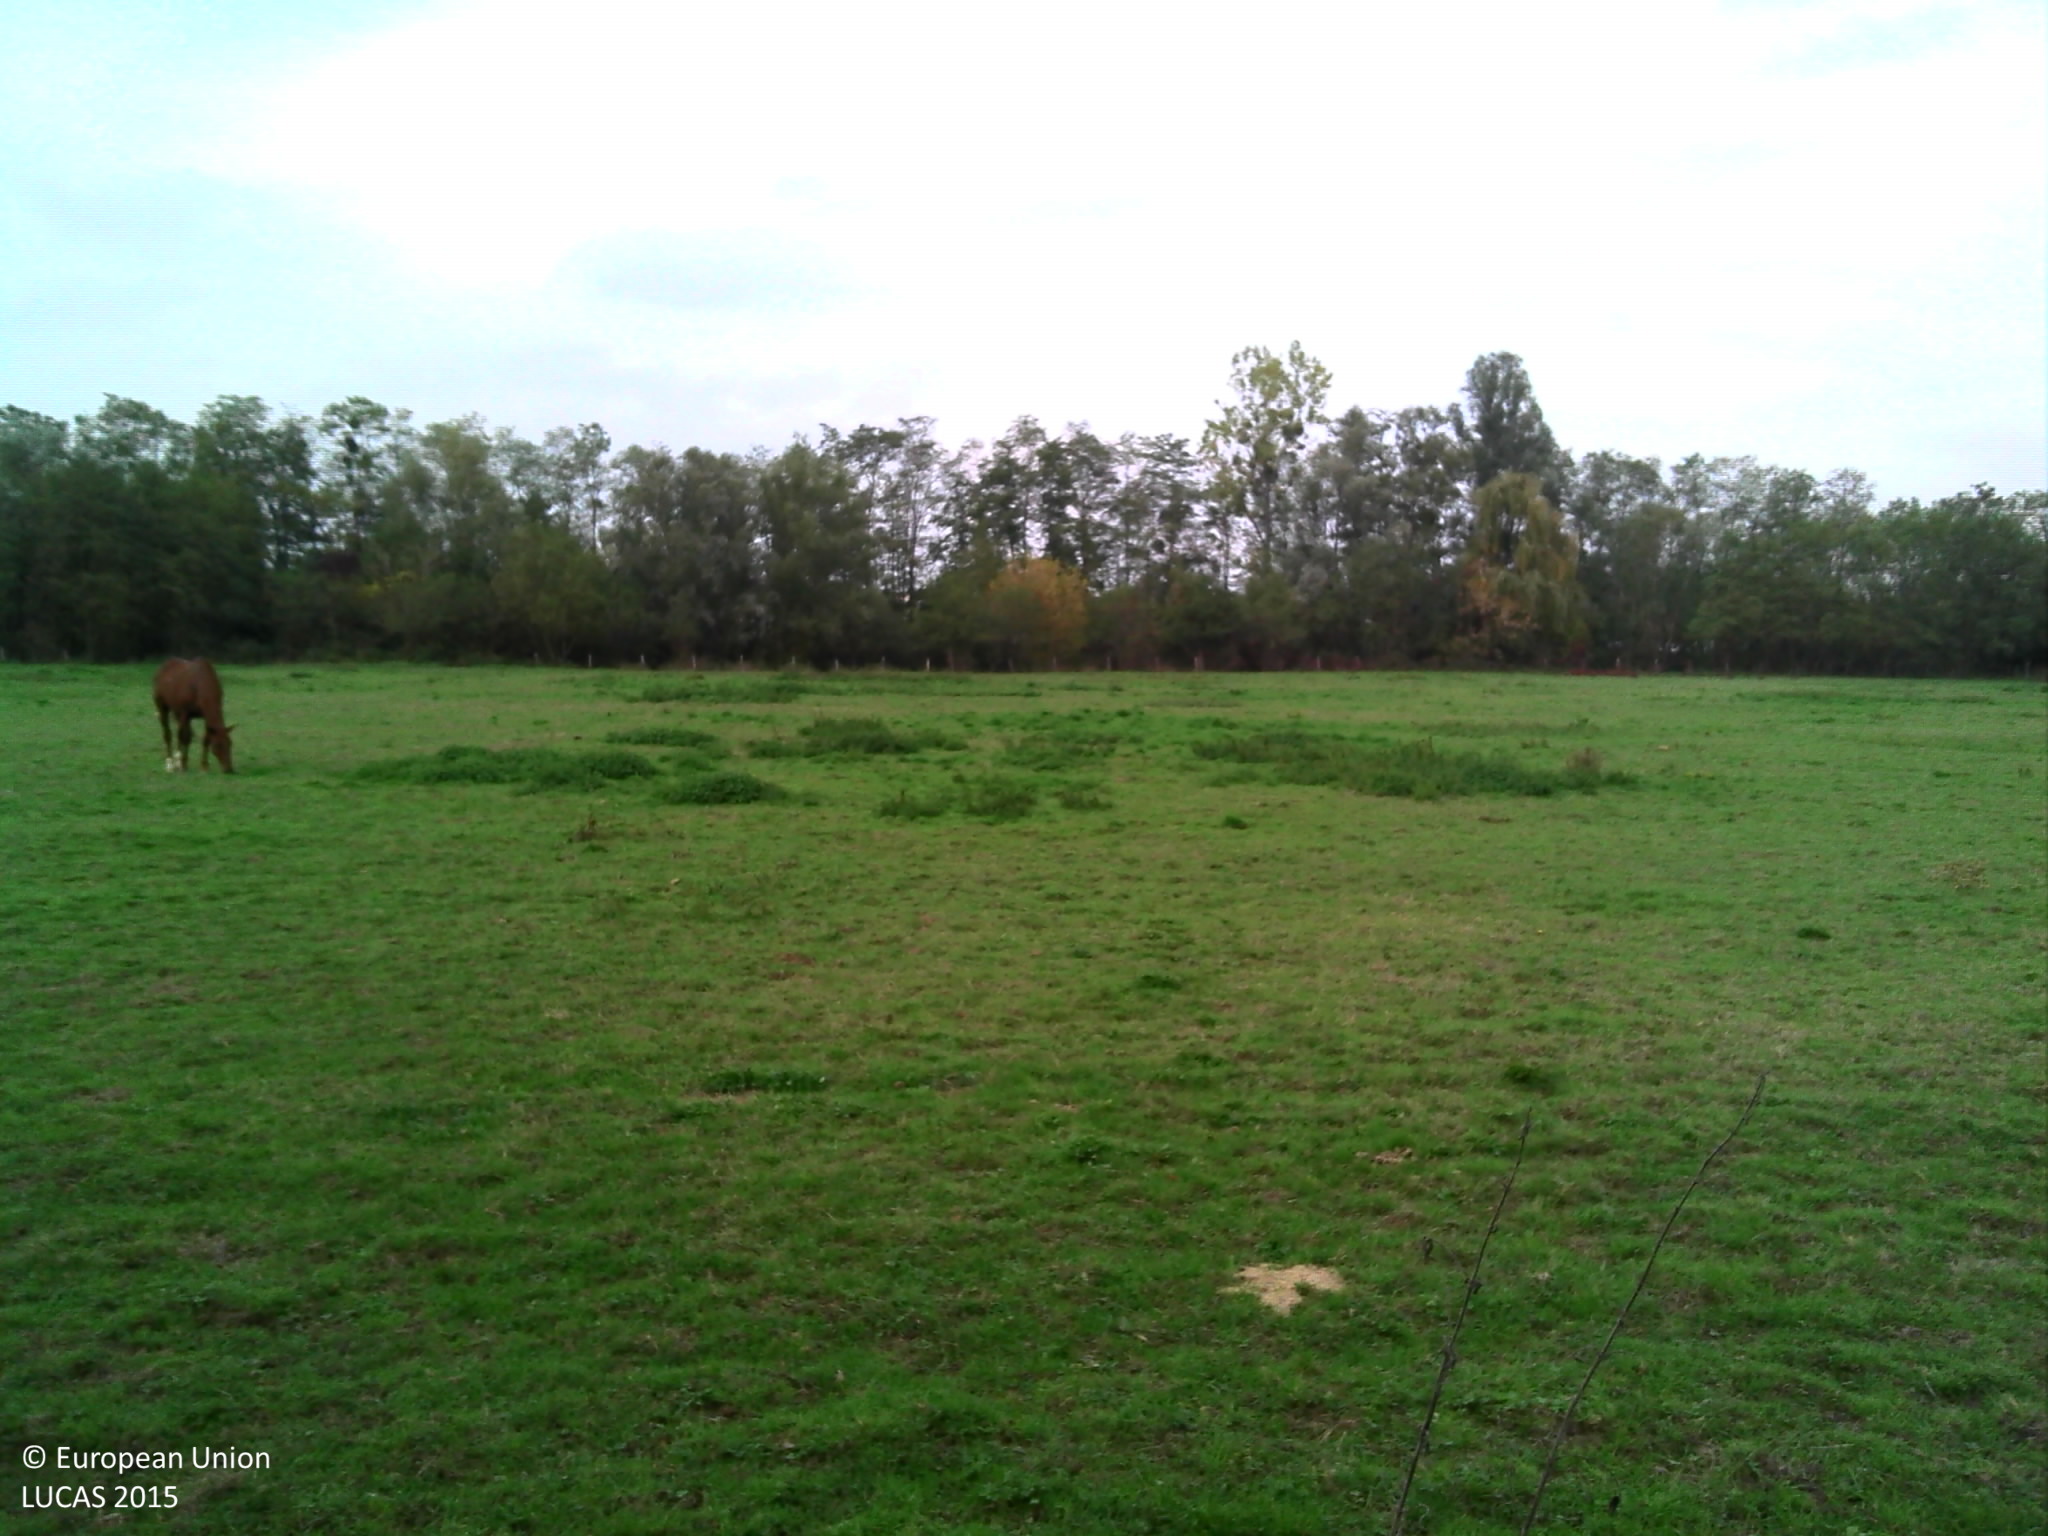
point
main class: Grassland
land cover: Grassland without tree/shrub cover
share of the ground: > 75 %
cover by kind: herbaceous plants 100 %
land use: Agriculture (excluding fallow land and kitchen gardens)
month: October
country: FR
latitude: 46.1710
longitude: 4.8087
